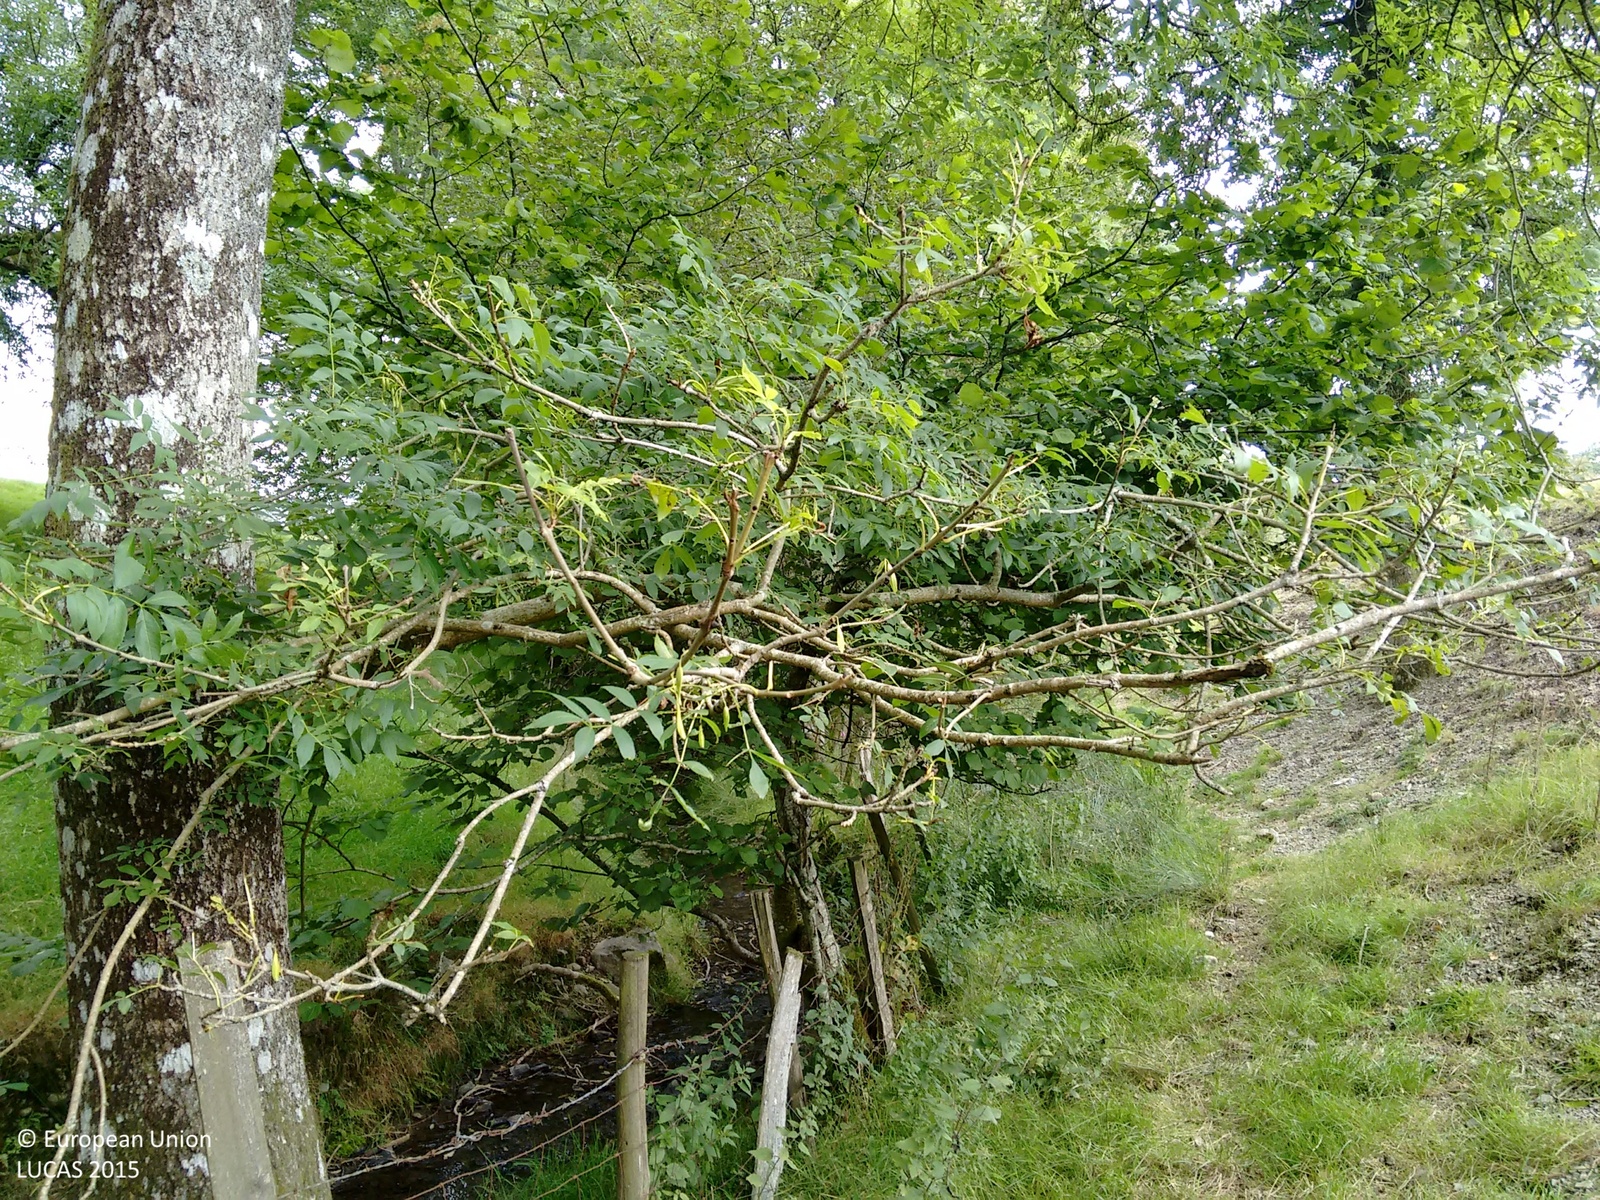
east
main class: Woodland
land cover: Broadleaved woodland
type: mesophytic deciduous forest
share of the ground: > 75 %
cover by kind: broadleaved forest trees 80 %, herbaceous plants 20 %
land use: Agriculture (excluding fallow land and kitchen gardens)
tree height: > 5 m
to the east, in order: Broadleaved woodland; Fences; Rivers and streams; Broadleaved woodland; Other mixed woodland; Fences; Broadleaved woodland
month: September
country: GB
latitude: 52.1823
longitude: -3.5257
